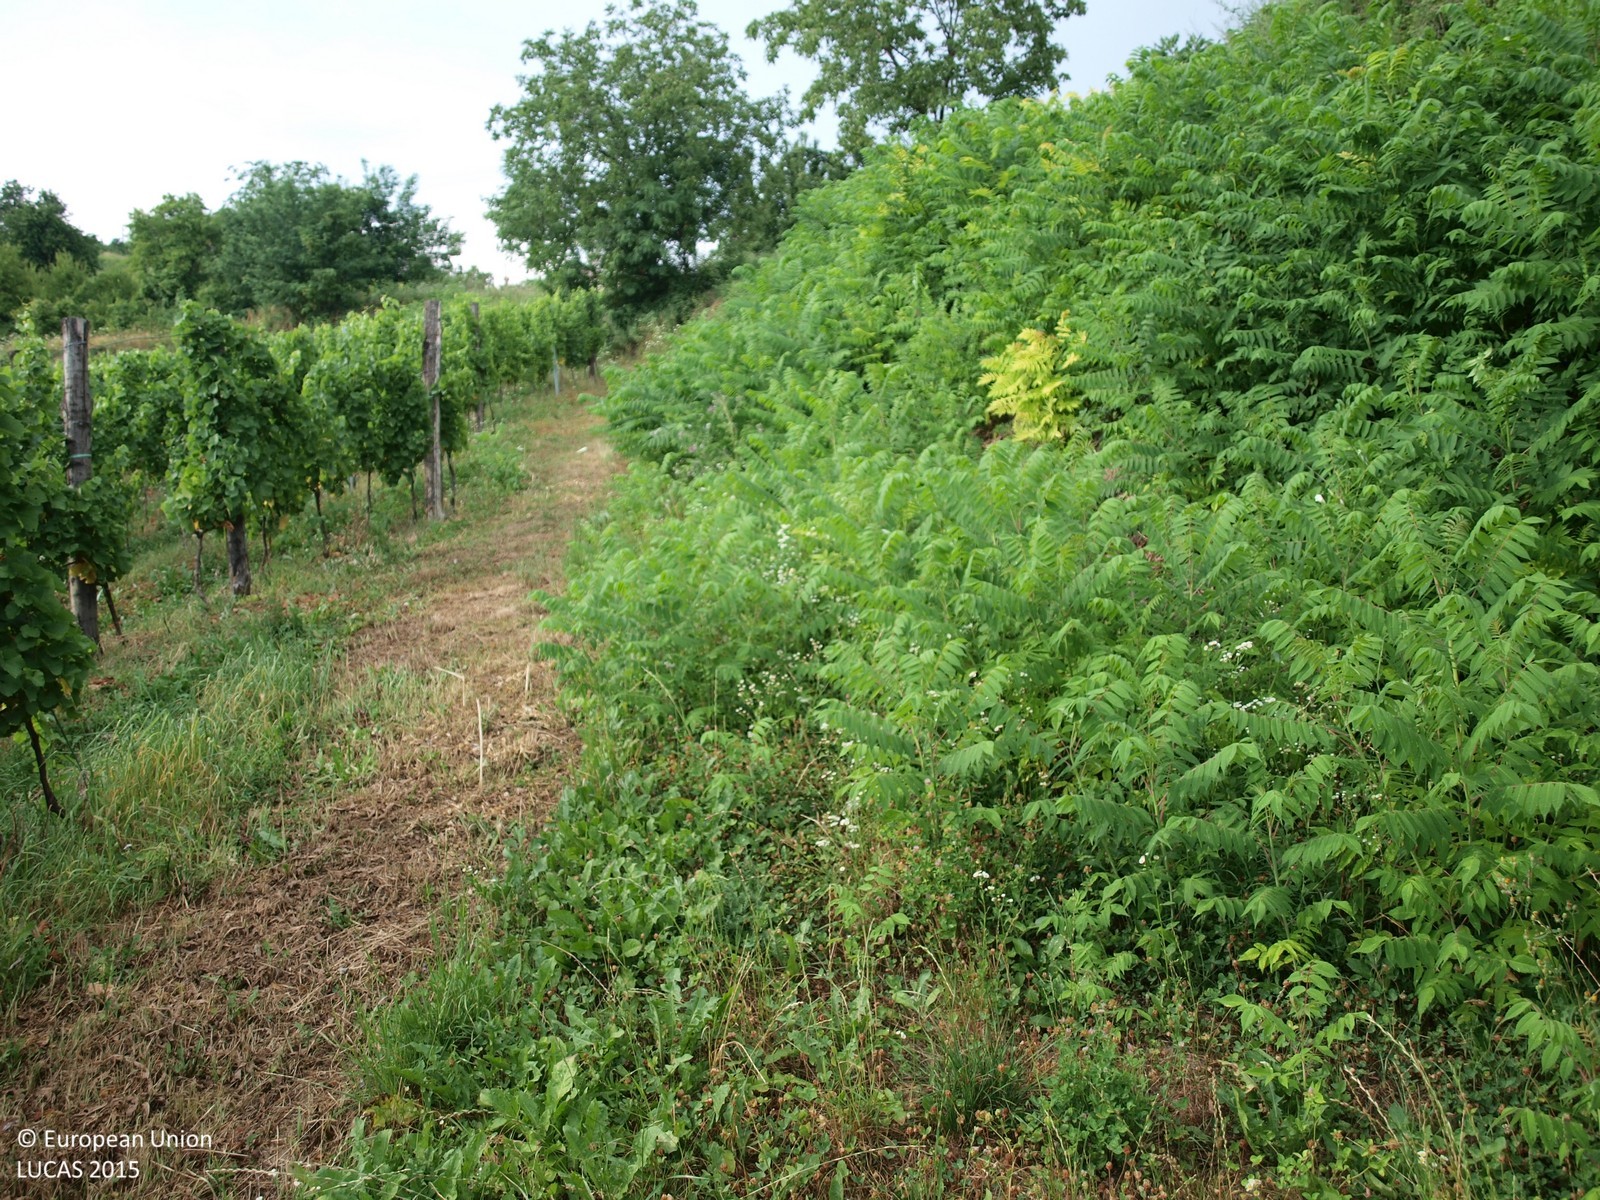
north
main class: Grassland
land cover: Grassland with sparse tree/shrub cover
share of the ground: > 75 %
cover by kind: herbaceous plants 95 %, broadleaved forest trees 5 %
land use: Agriculture (excluding fallow land and kitchen gardens)
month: July
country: HR
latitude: 45.9378
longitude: 16.1768
